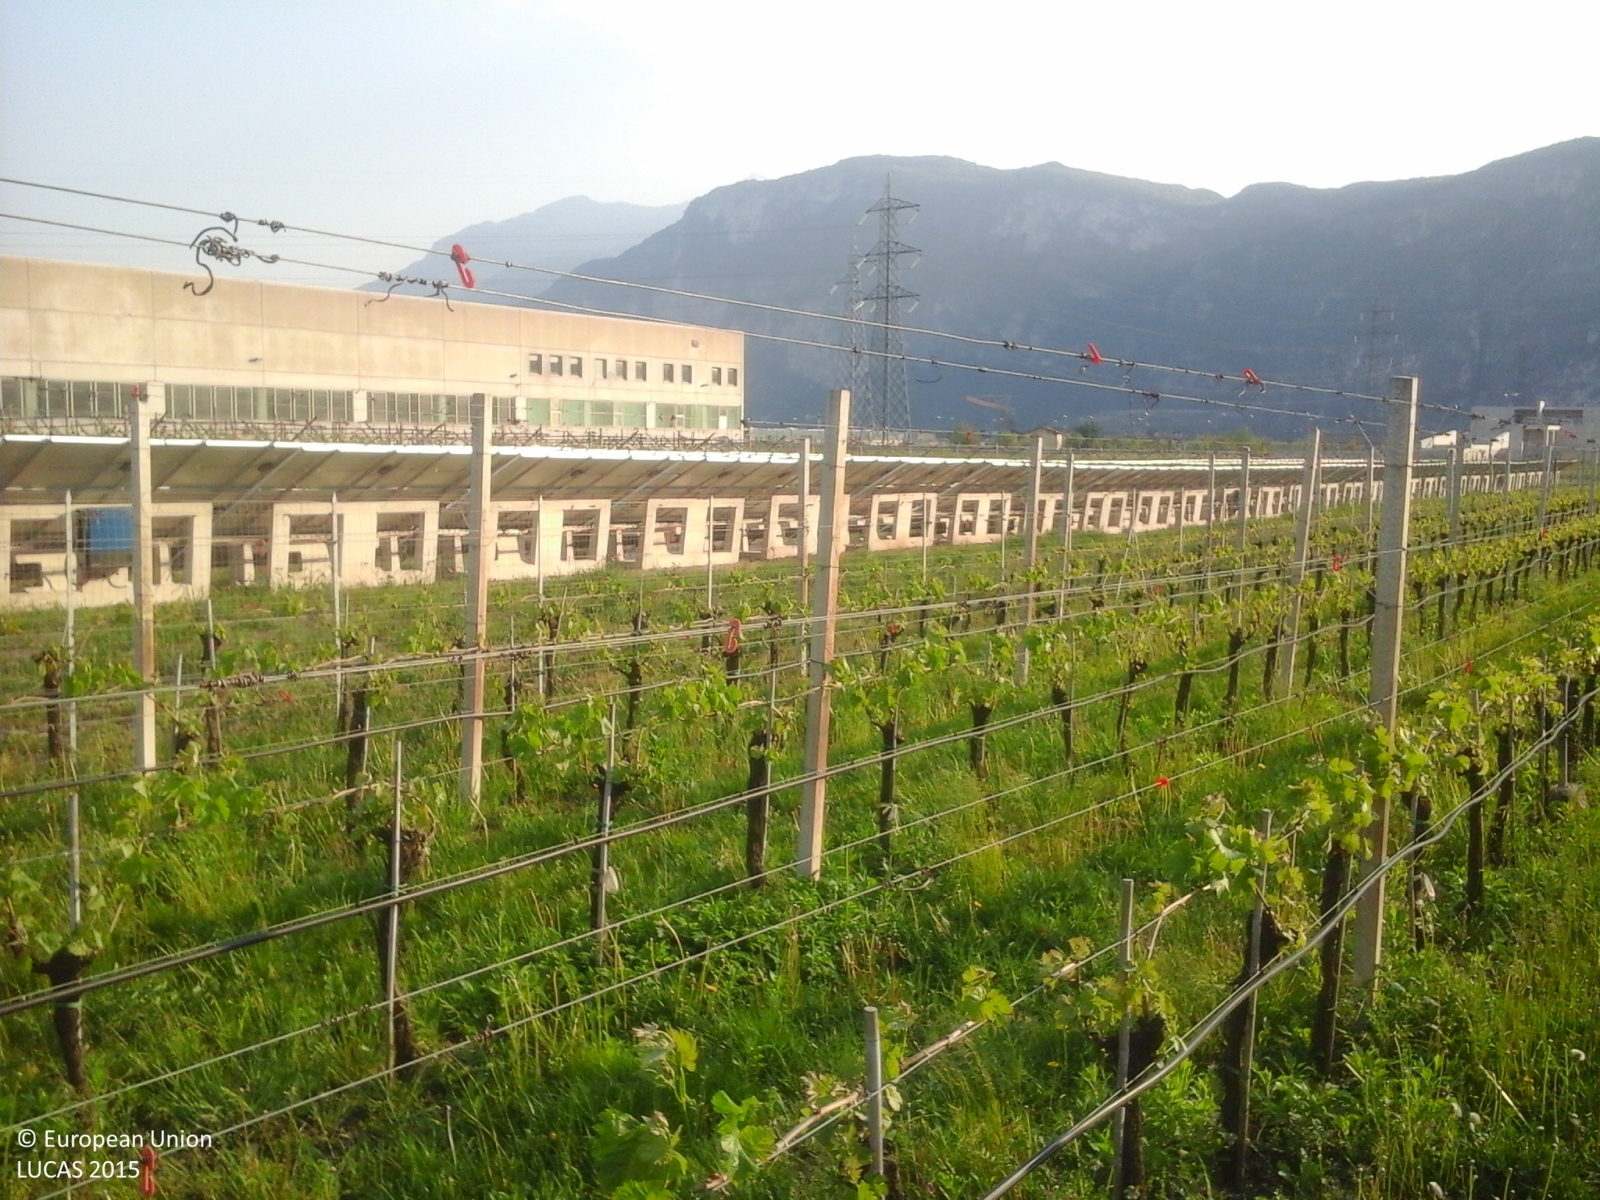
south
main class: Cropland
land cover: Vineyards
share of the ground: < 10 %
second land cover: Grassland without tree/shrub cover
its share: > 75 %
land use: Agriculture (excluding fallow land and kitchen gardens)
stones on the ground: < 10 %
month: April
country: IT
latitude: 46.1294
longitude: 11.0986
